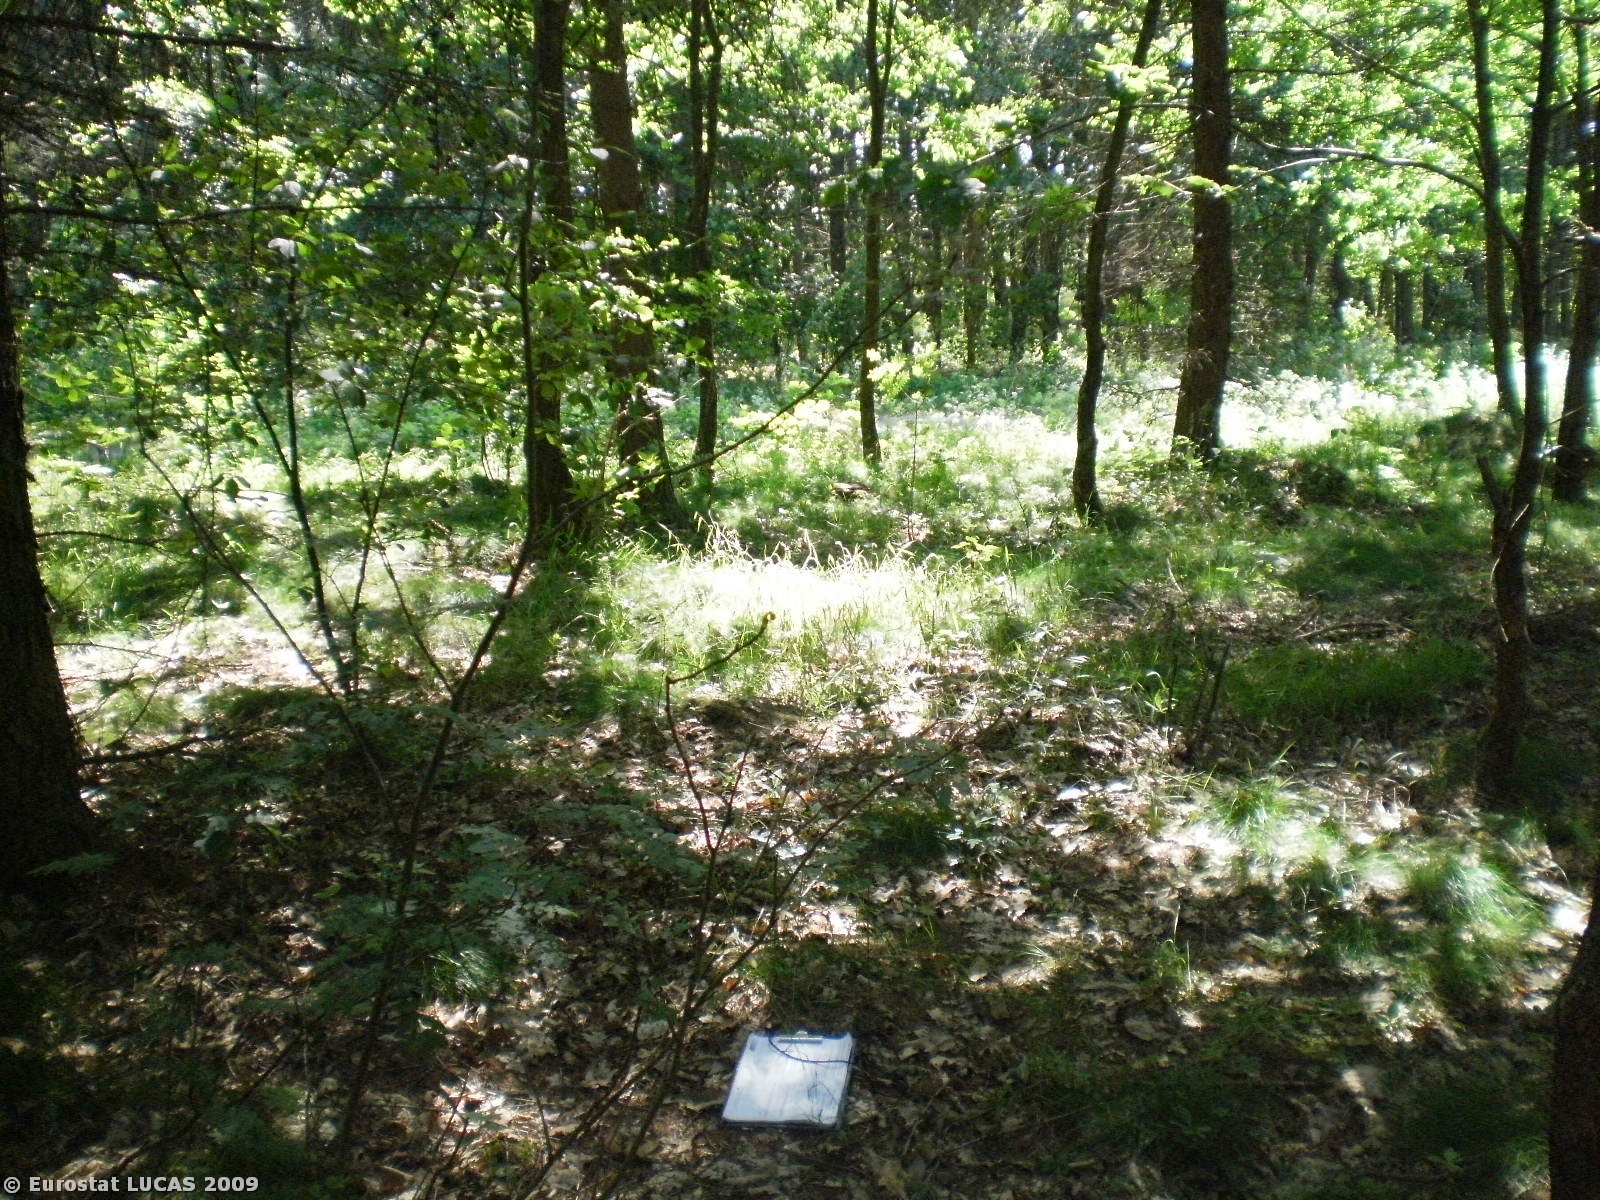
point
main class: Woodland
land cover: Mixed woodland
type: hemiboreal forest and nemoral coniferous forest and mixed broadleaved-coniferous forest
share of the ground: > 75 %
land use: Forestry
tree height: > 5 m
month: June
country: PL
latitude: 54.4628
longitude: 17.3066
